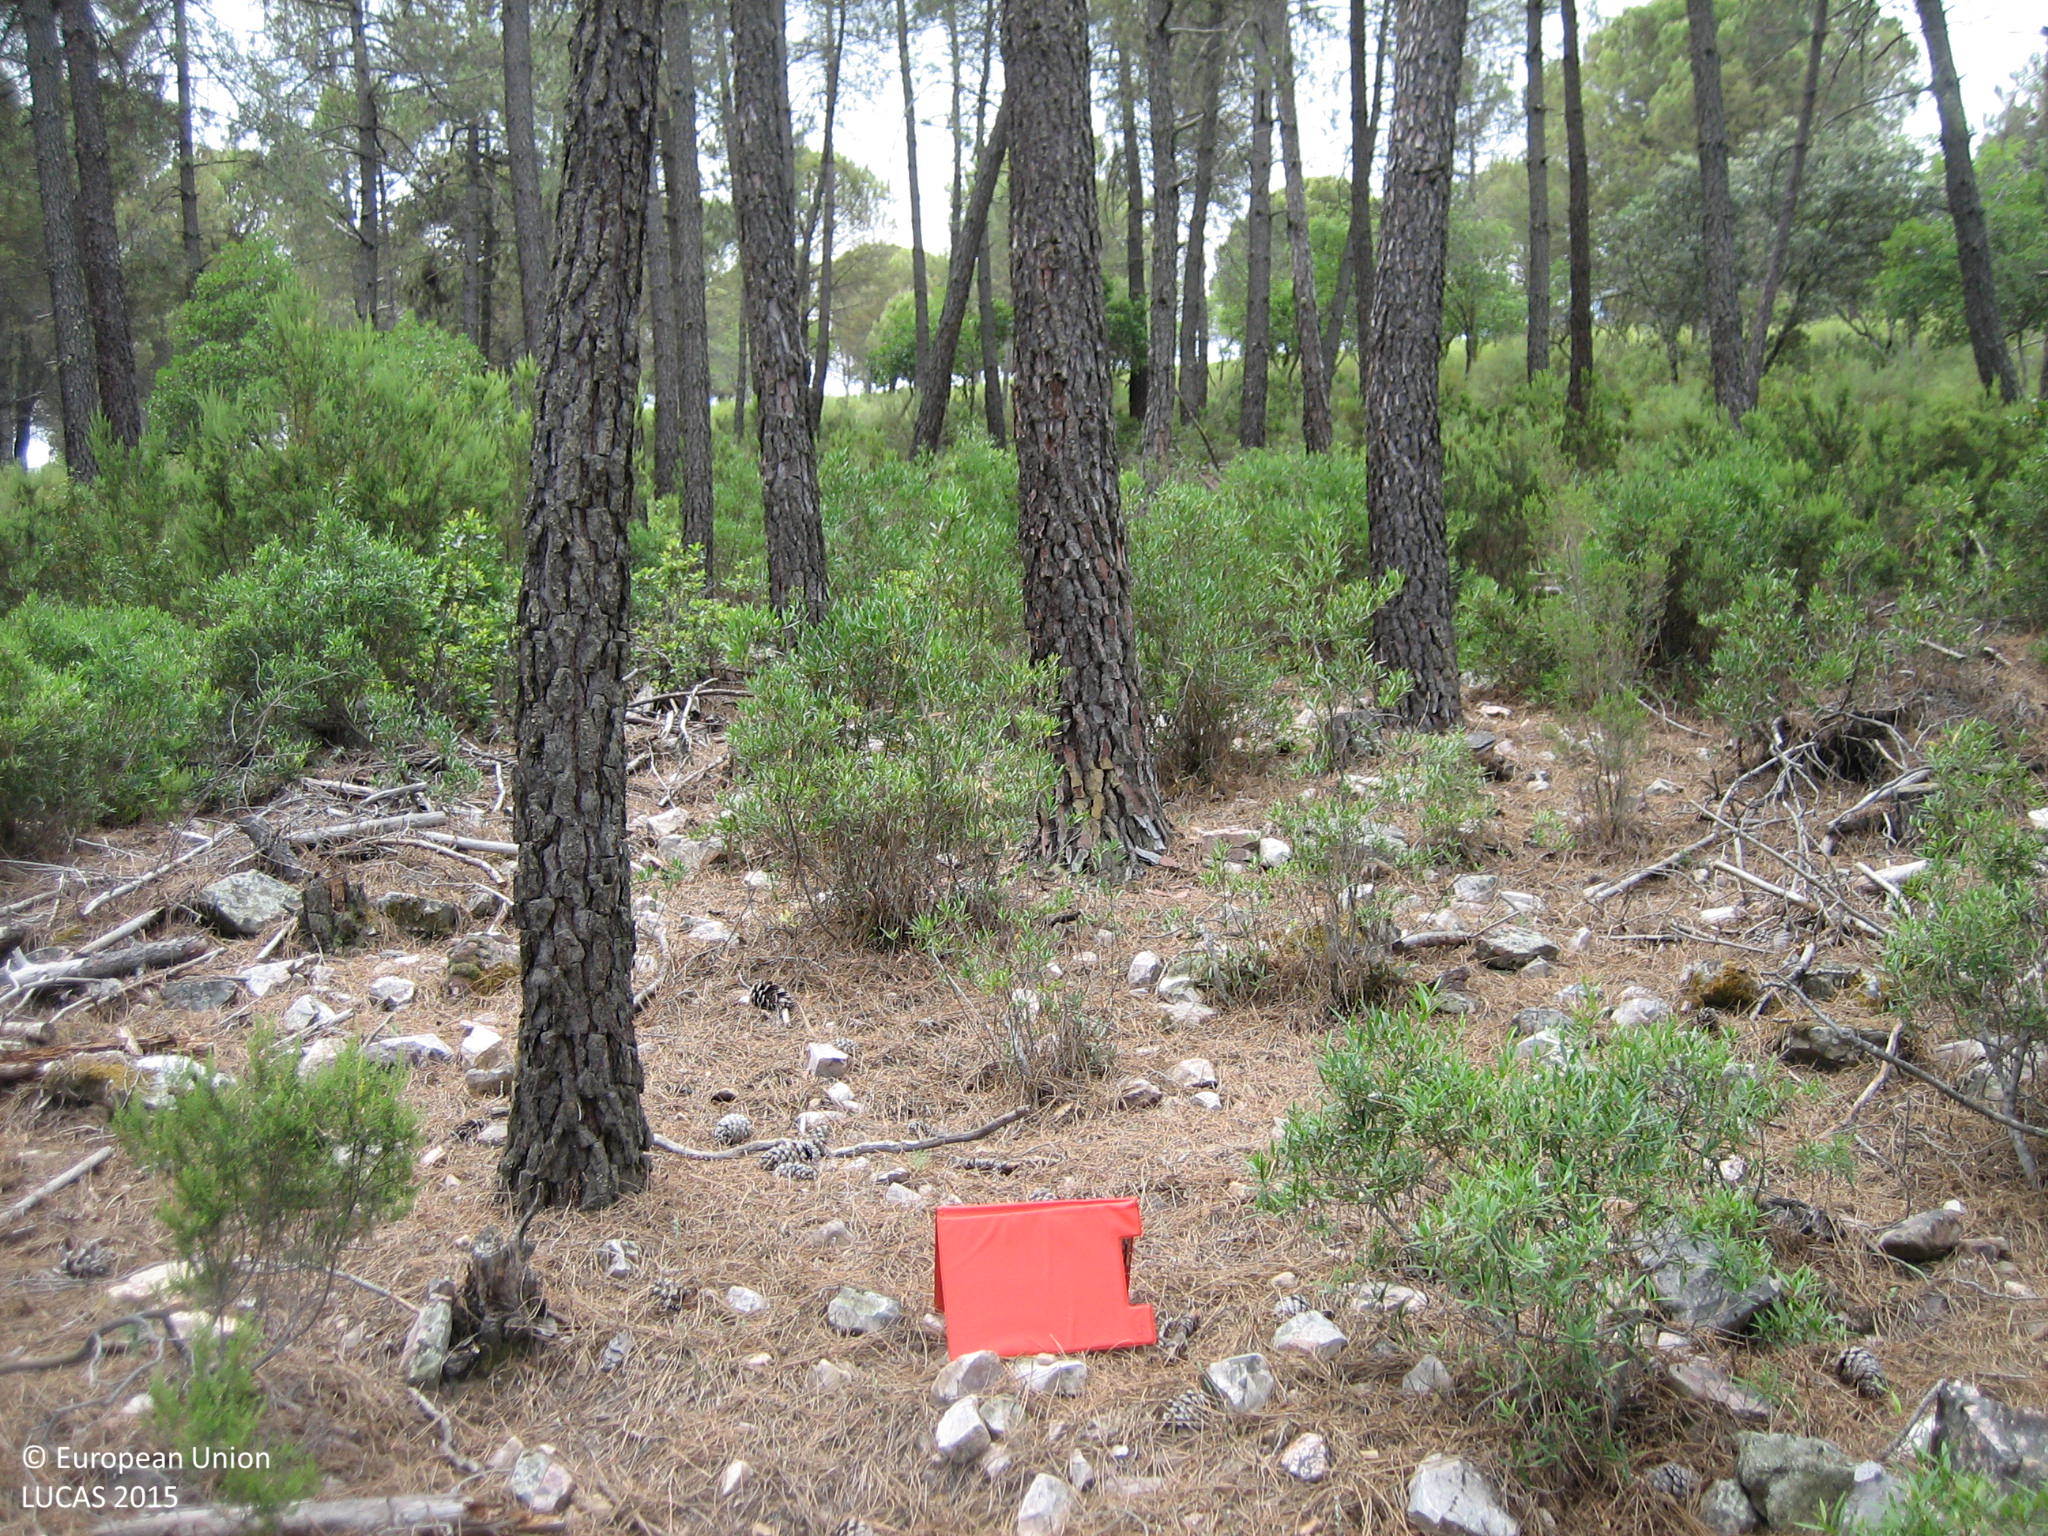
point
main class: Woodland
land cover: Pine dominated coniferous woodland
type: coniferous forest of the mediterranean region
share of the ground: > 75 %
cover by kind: coniferous forest trees 90 %, shrubs 10 %
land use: Forestry
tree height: > 5 m
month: June
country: ES
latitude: 39.2890
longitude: -4.7727
